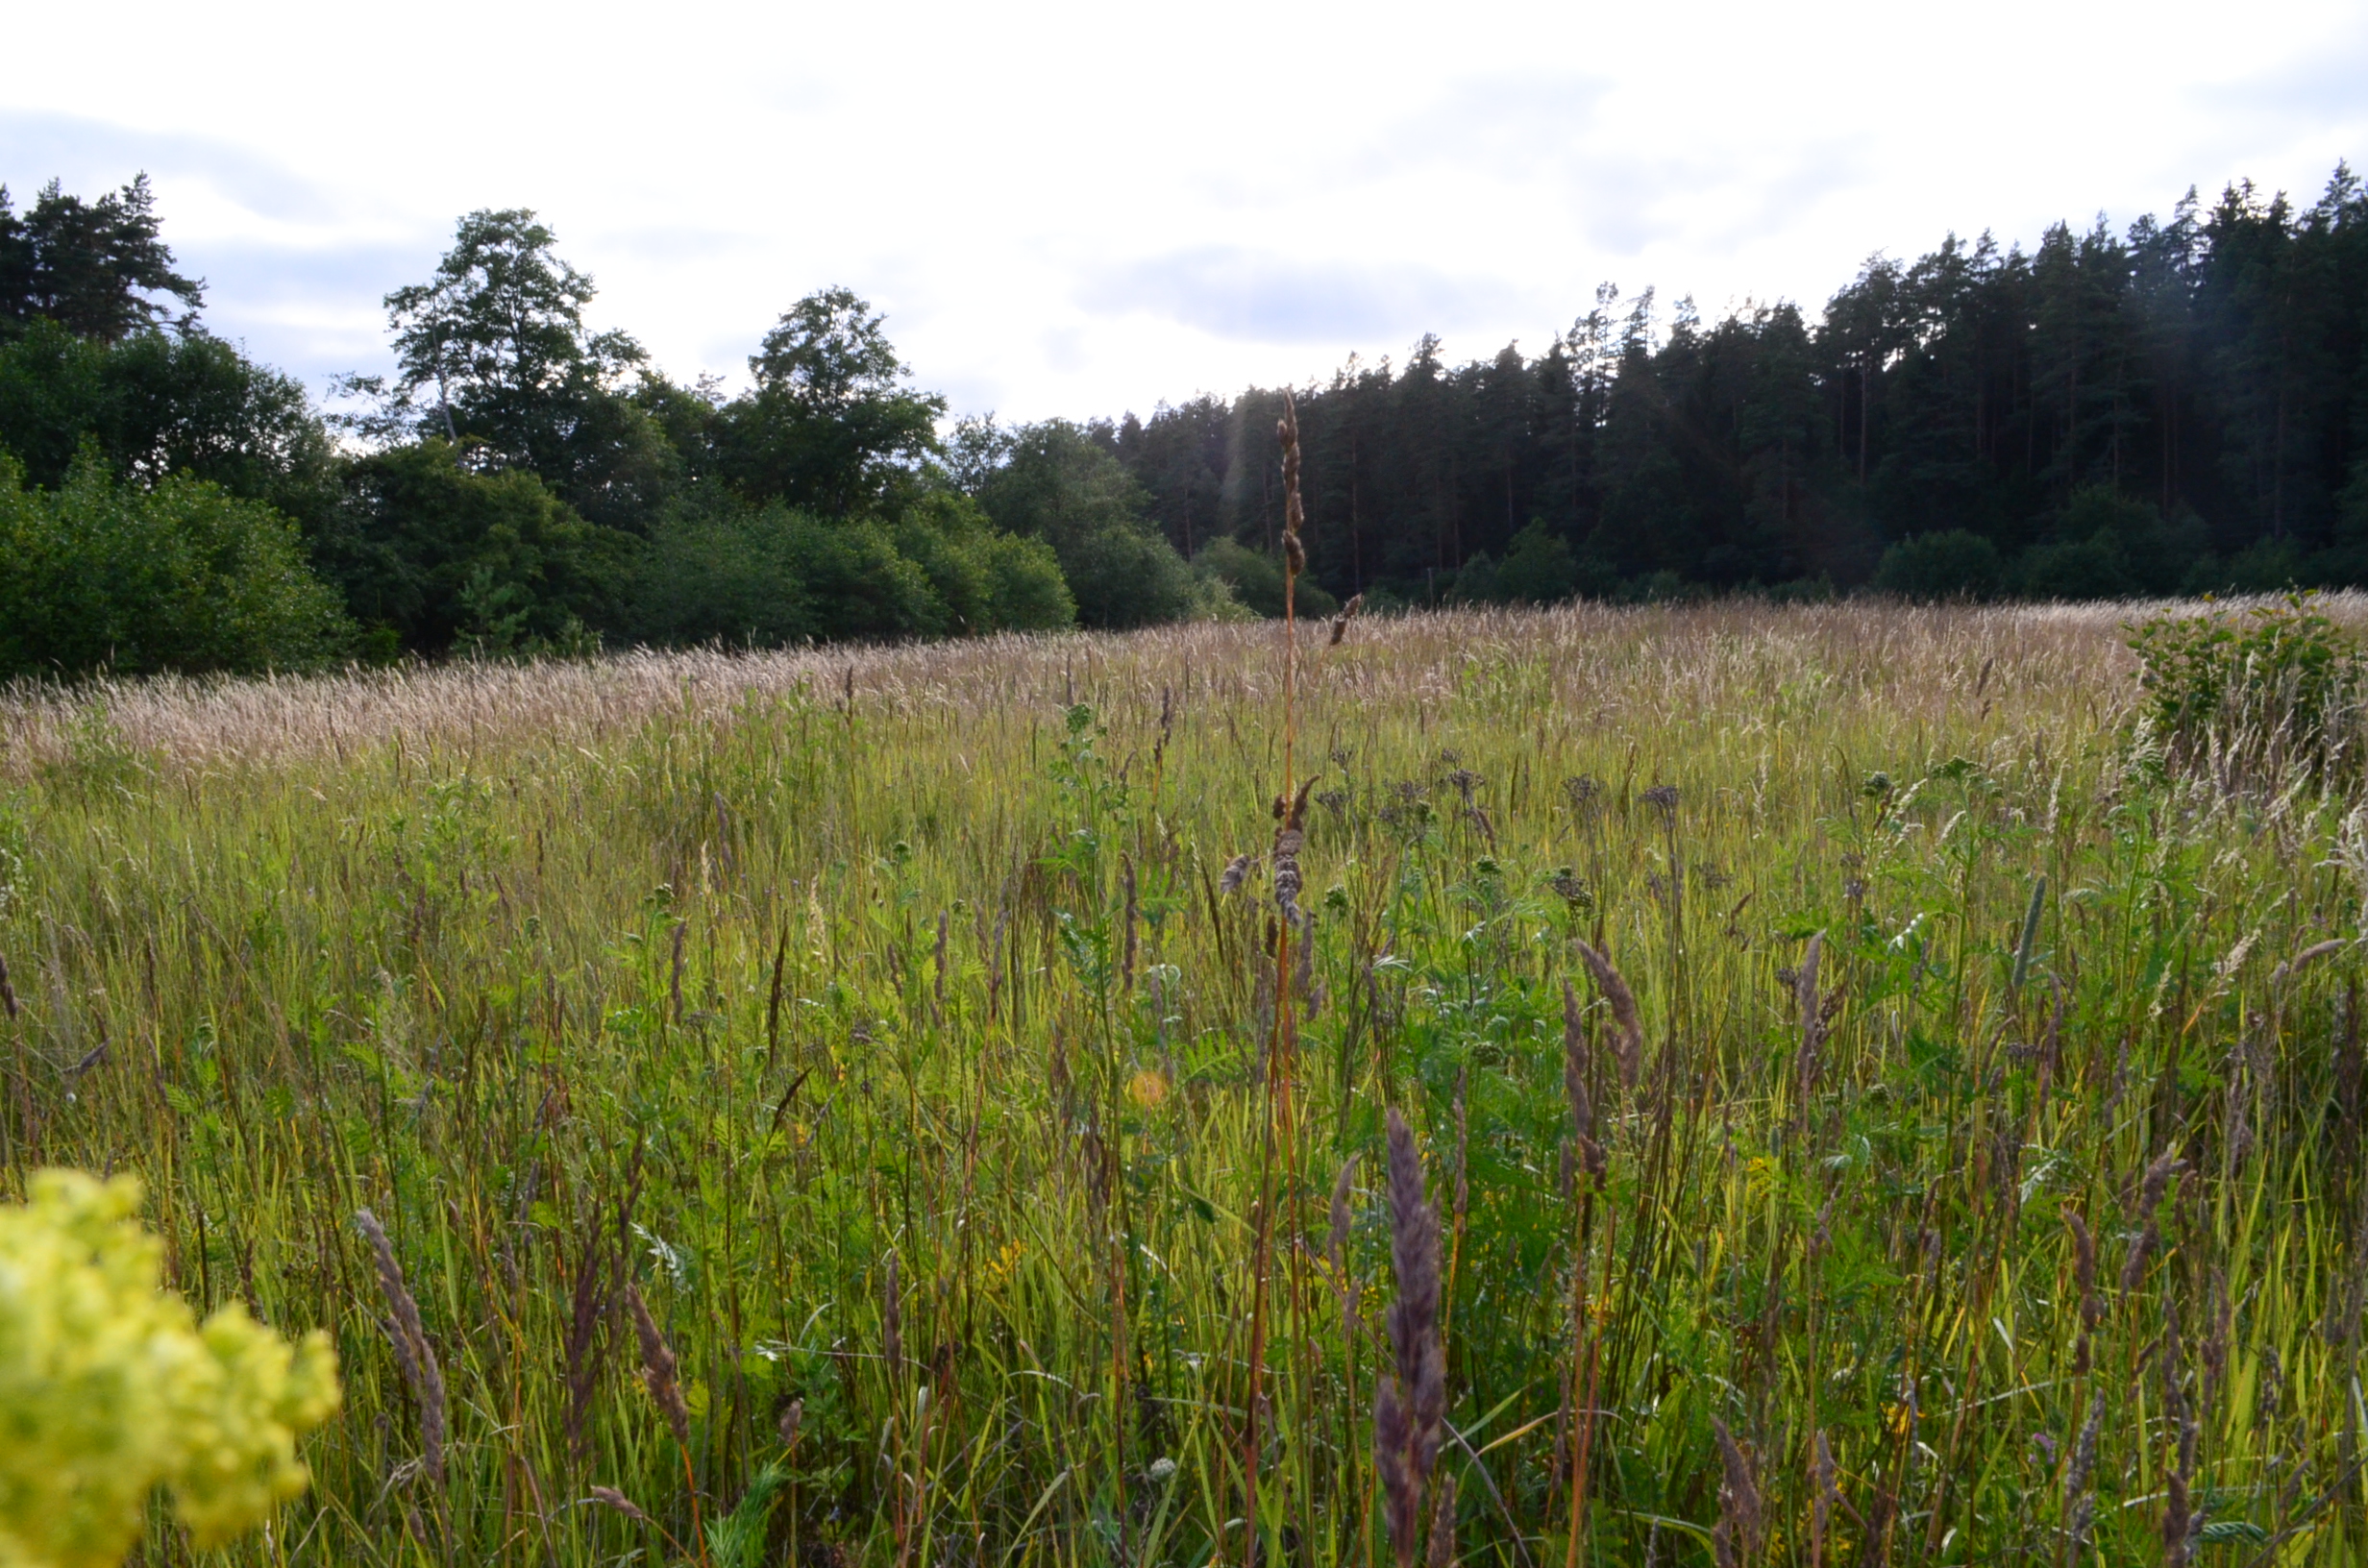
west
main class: Grassland
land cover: Spontaneously vegetated surfaces
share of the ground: > 75 %
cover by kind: herbaceous plants 100 %
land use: Semi-natural and natural areas not in use
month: July
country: LV
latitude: 57.0712
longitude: 22.2734
